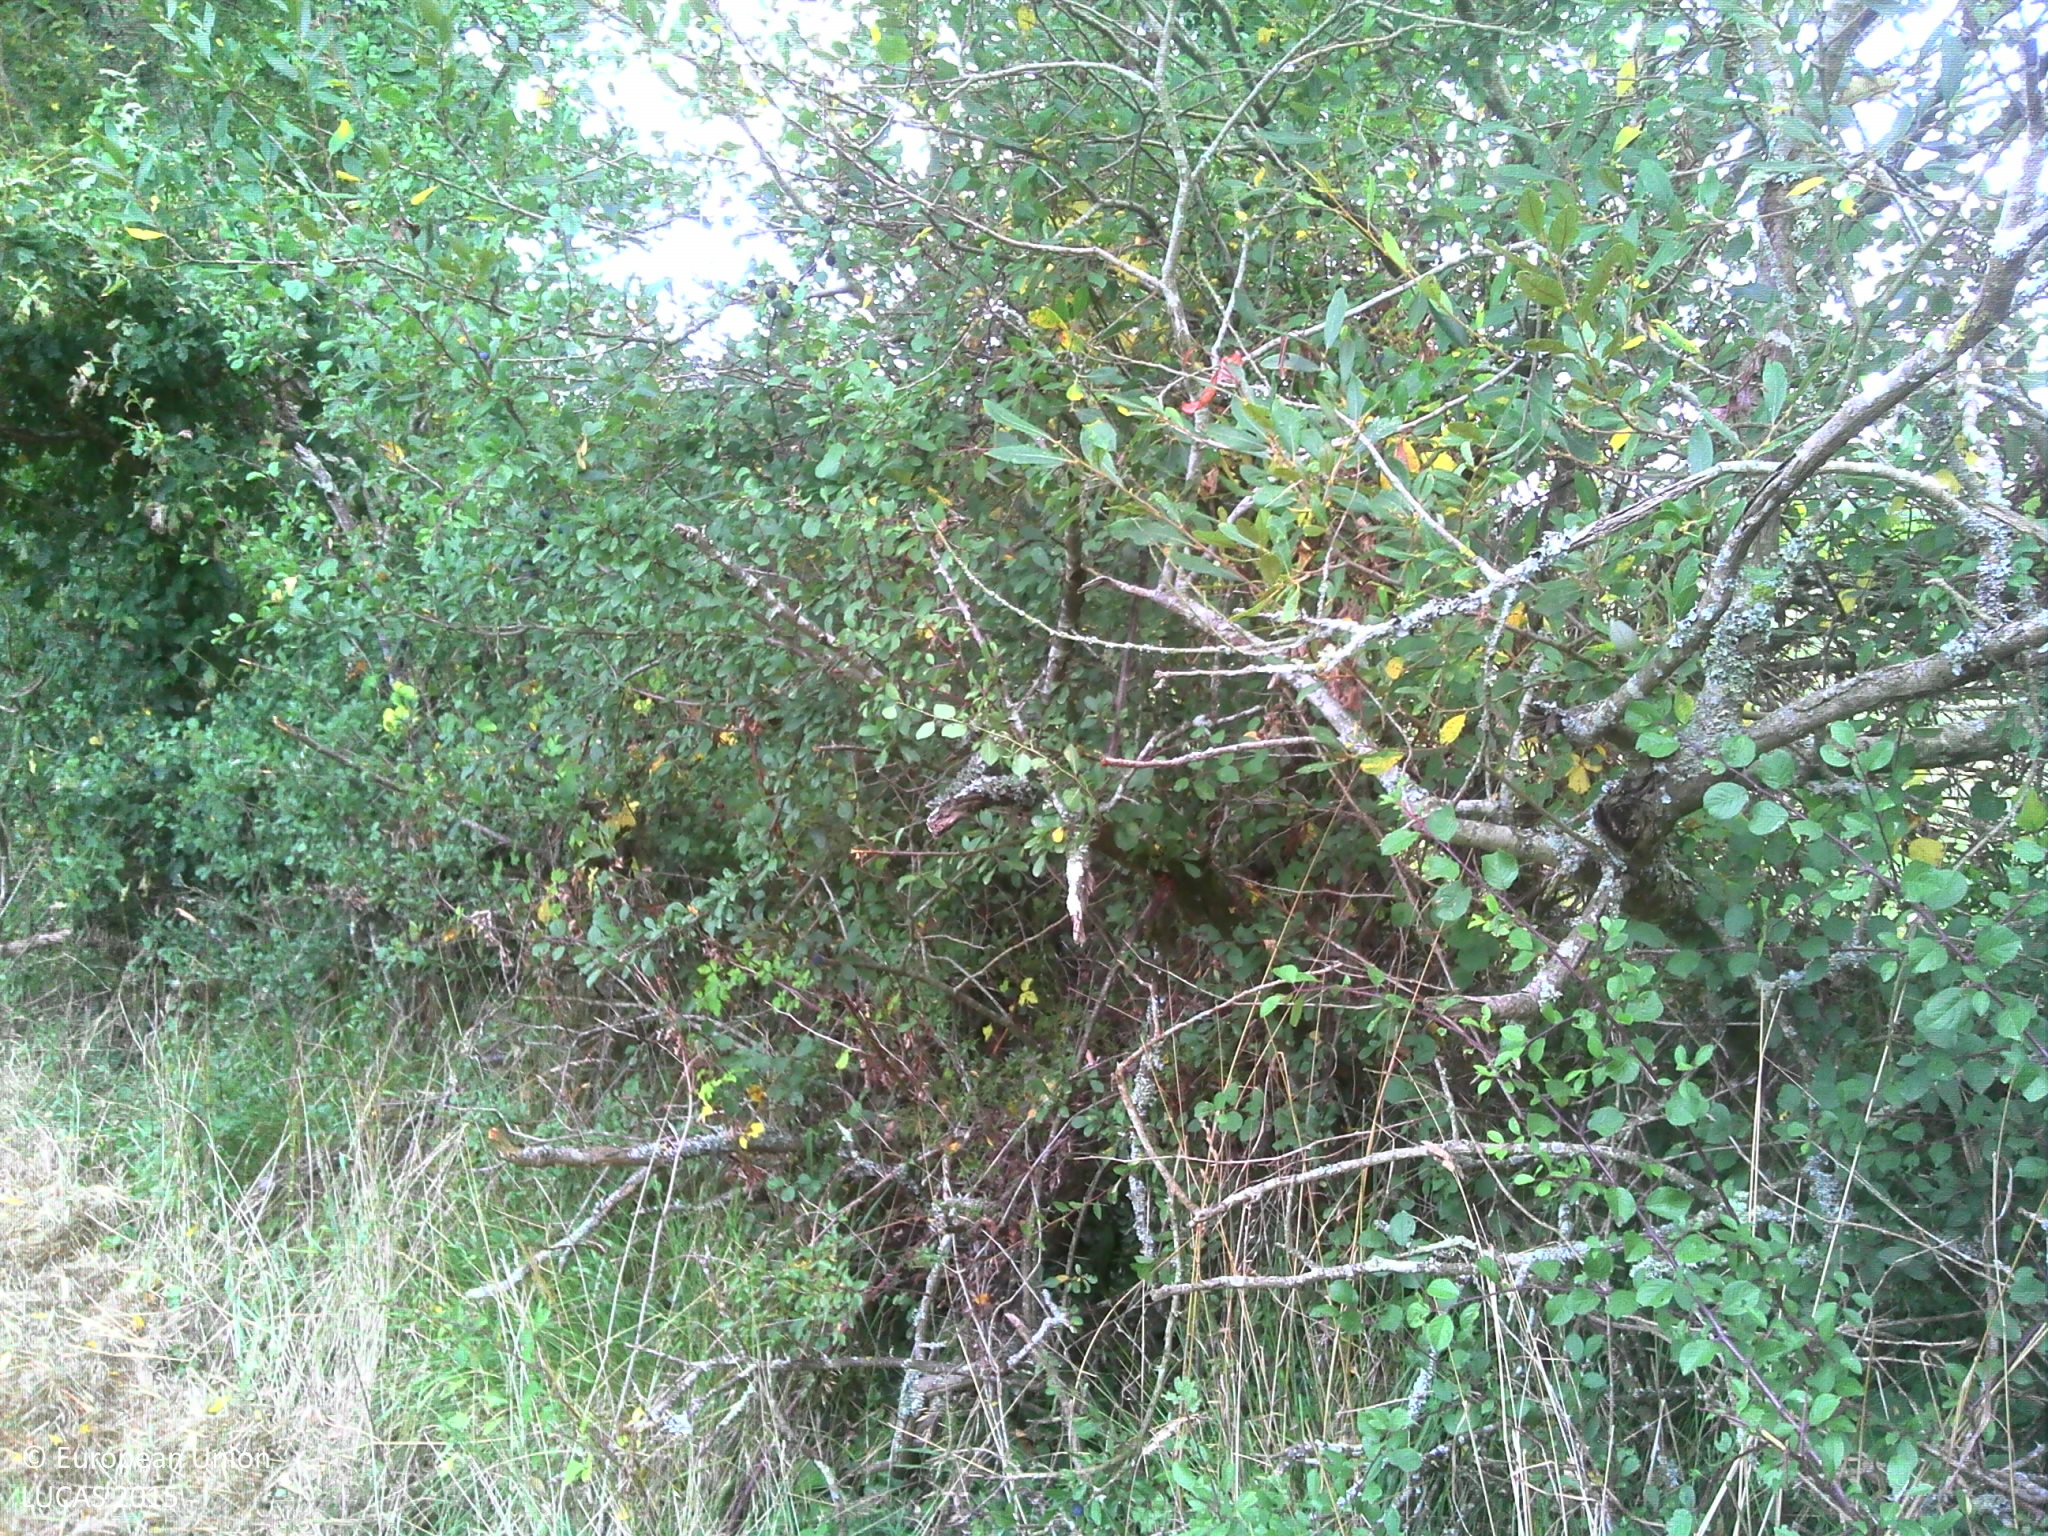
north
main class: Grassland
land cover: Grassland without tree/shrub cover
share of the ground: > 75 %
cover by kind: herbaceous plants 100 %
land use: Agriculture (excluding fallow land and kitchen gardens)
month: August
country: FR
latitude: 46.7104
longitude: -1.6698
